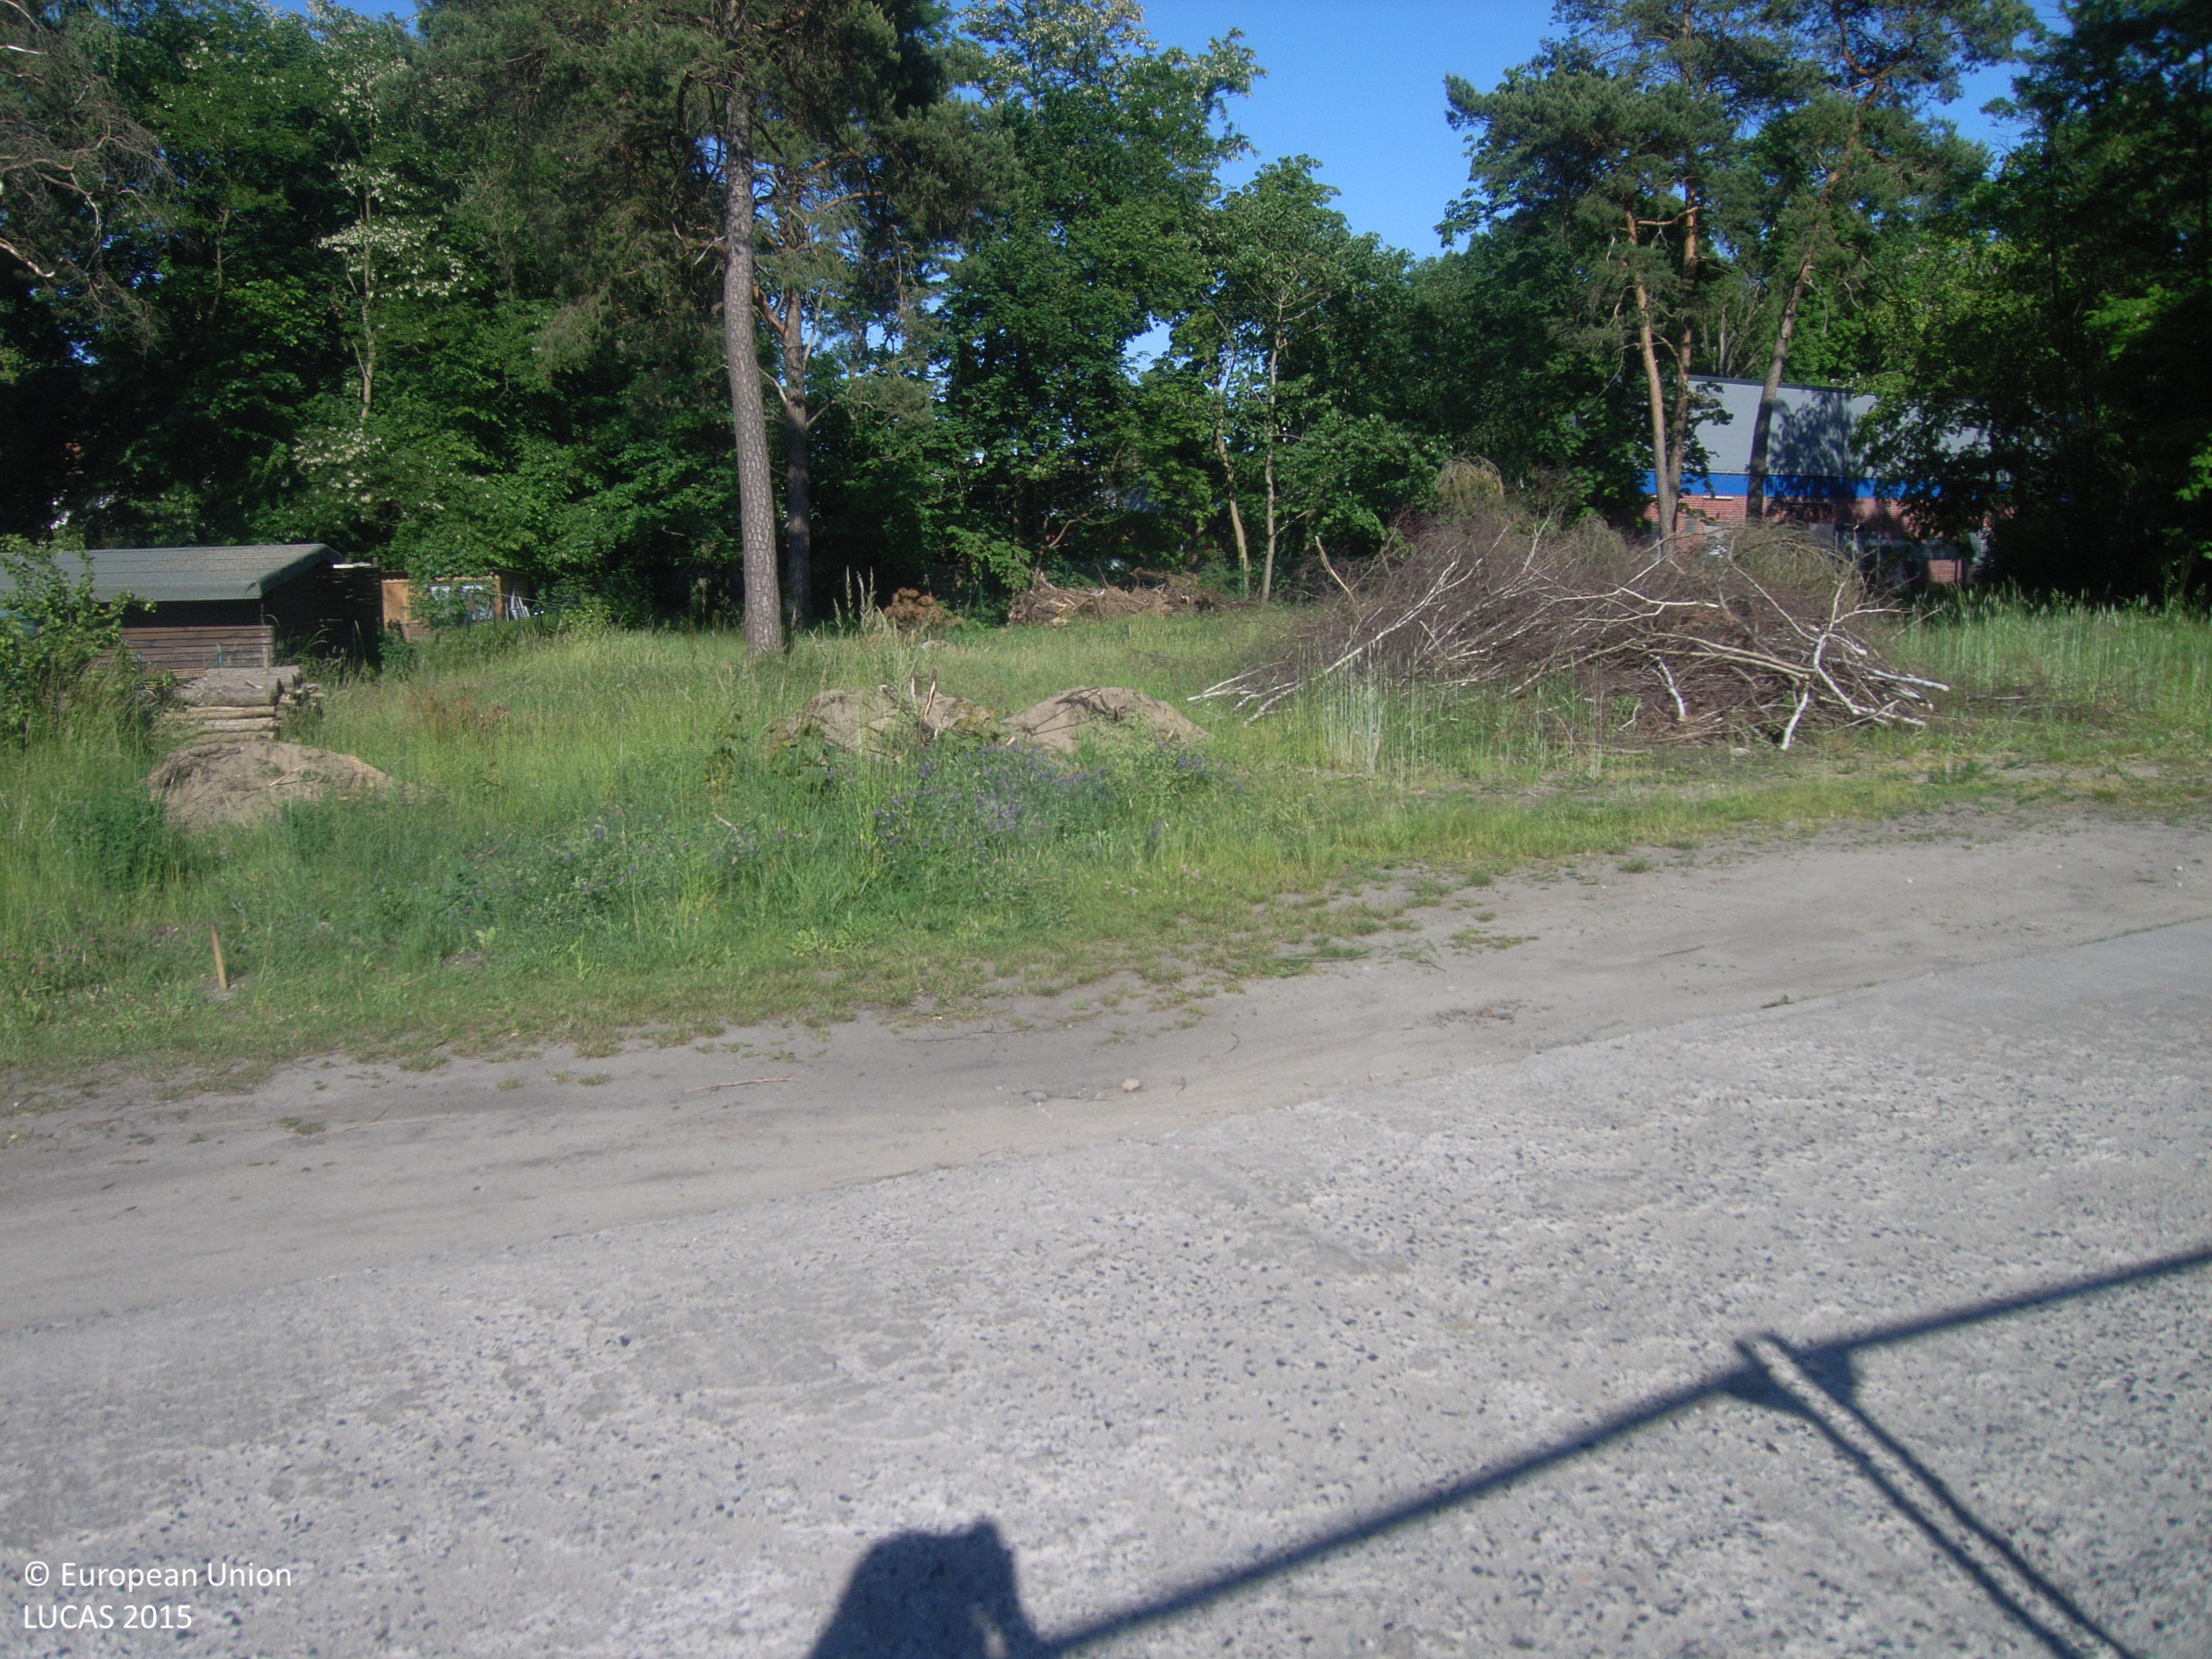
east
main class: Grassland
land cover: Grassland without tree/shrub cover
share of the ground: > 75 %
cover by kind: herbaceous plants 100 %
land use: Construction
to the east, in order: Grassland without tree/shrub cover; Artificial constructions in urban areas; Grassland without tree/shrub cover
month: June
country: DE
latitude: 52.2416
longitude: 14.4096
